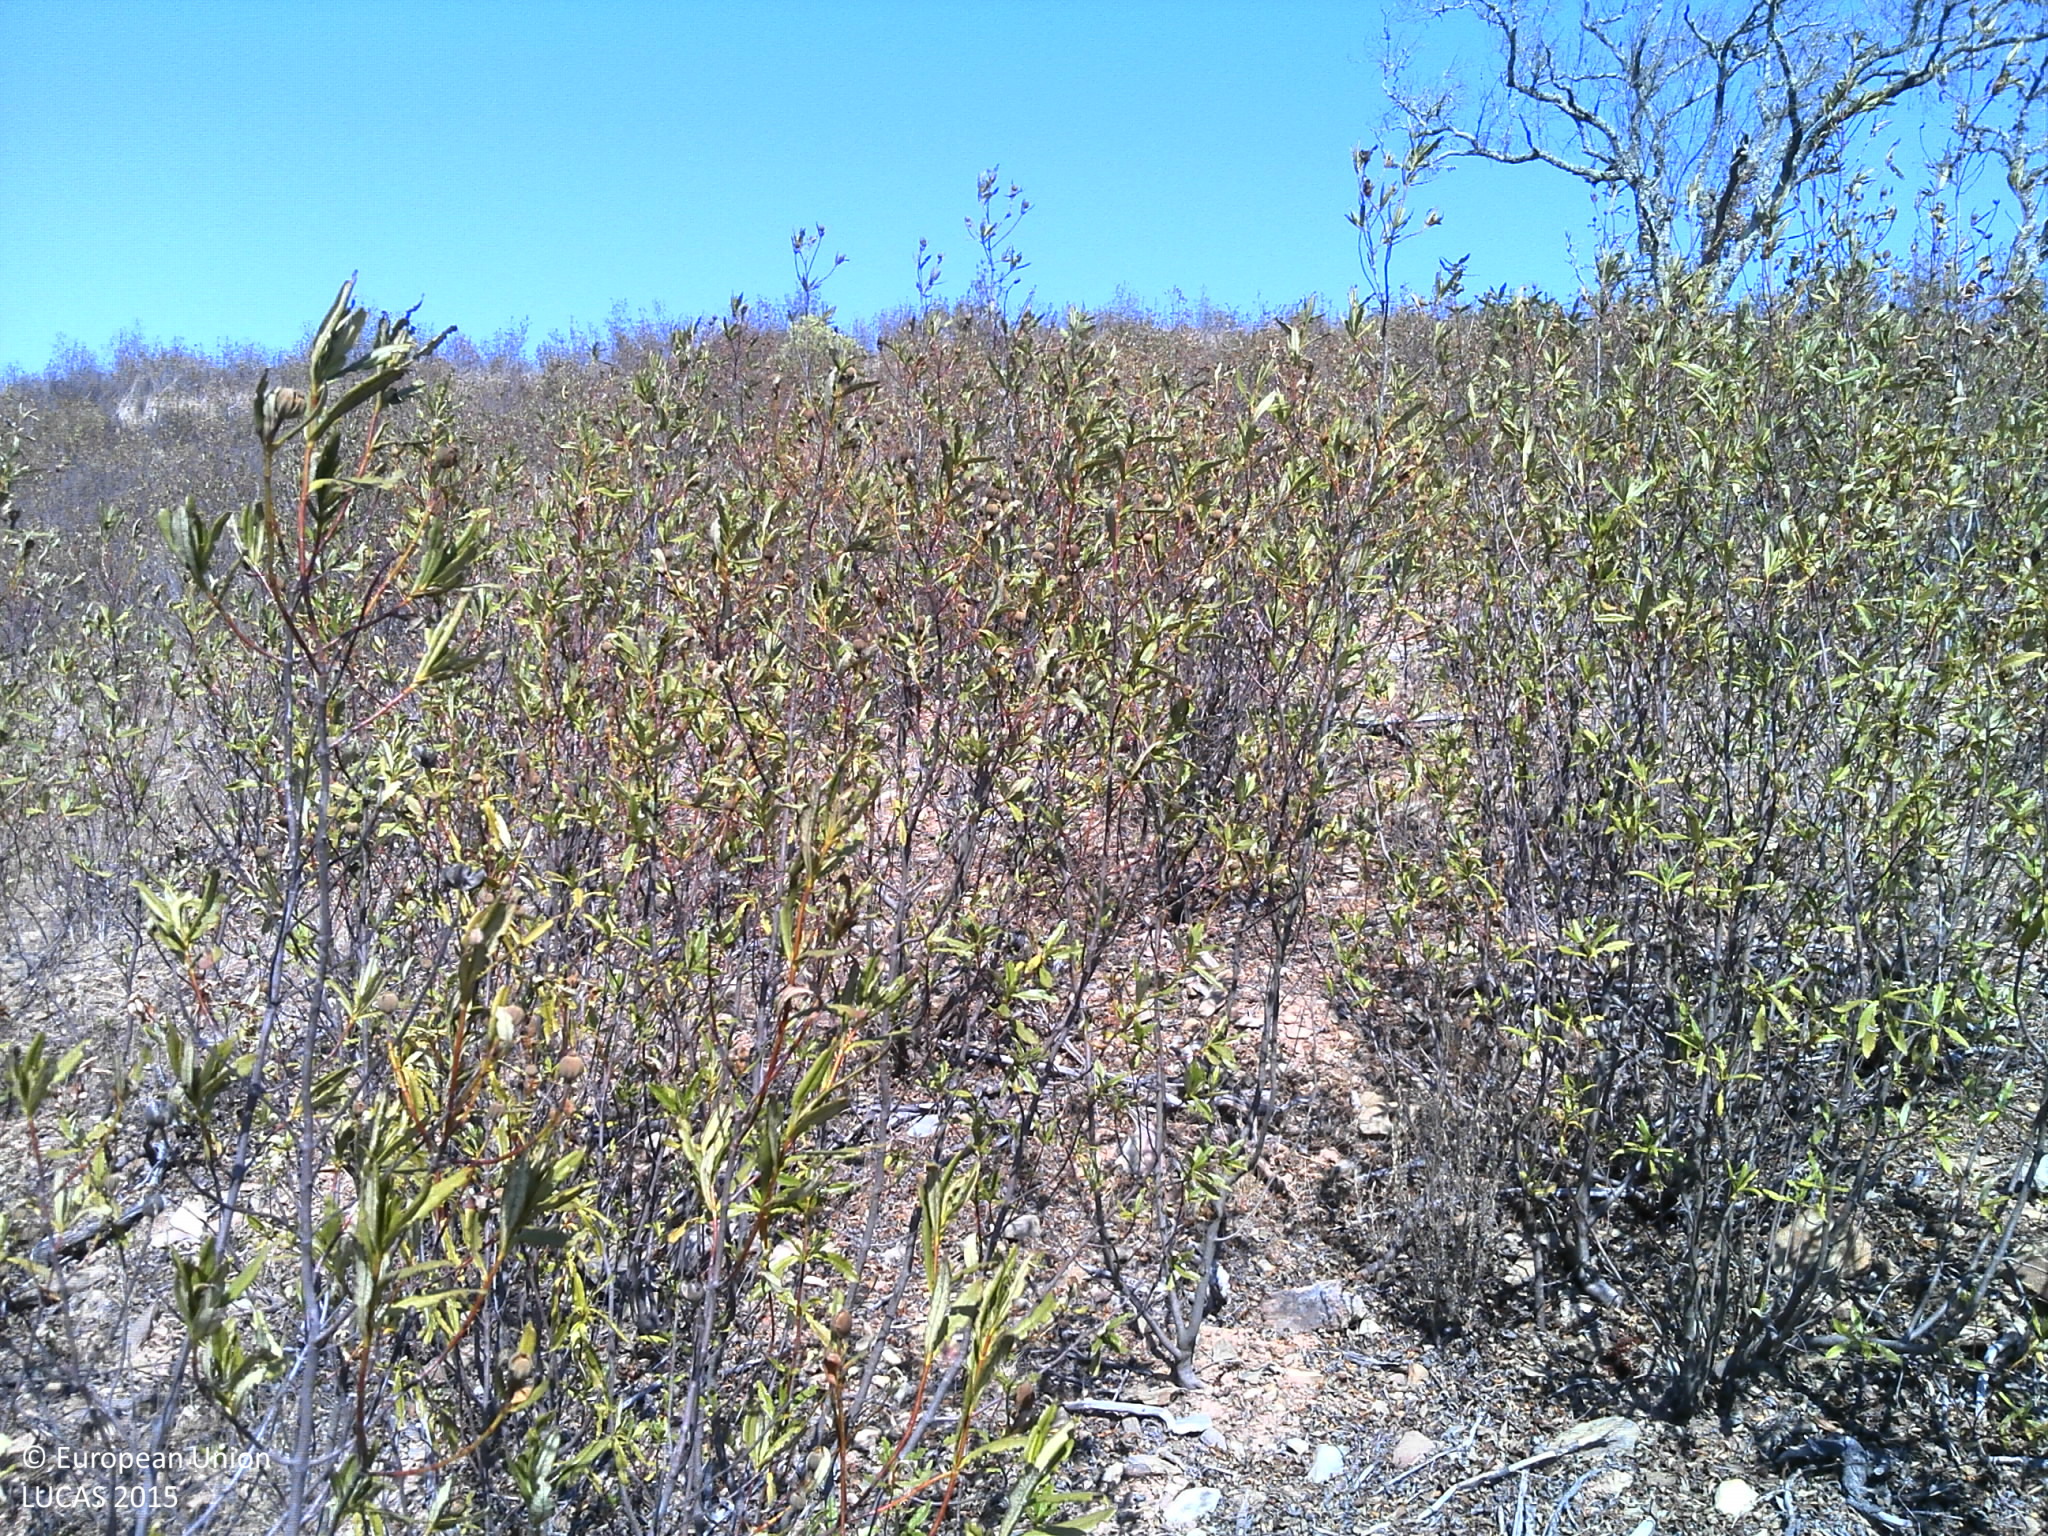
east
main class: Shrubland
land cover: Shrubland without tree cover
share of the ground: 25 - 50 %
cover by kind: unconsolidated bare surface 55 %, shrubs 45 %
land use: Abandoned areas
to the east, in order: Shrubland without tree cover; Single bushes/trees; Shrubland without tree cover; Fences; Grassland without tree/shrub cover; Shrubland without tree cover; Fences; Shruby margins; Tracks; Shrubland with sparse tree cover; Shrubland without tree cover
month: September
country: PT
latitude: 37.4586
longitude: -8.1916
